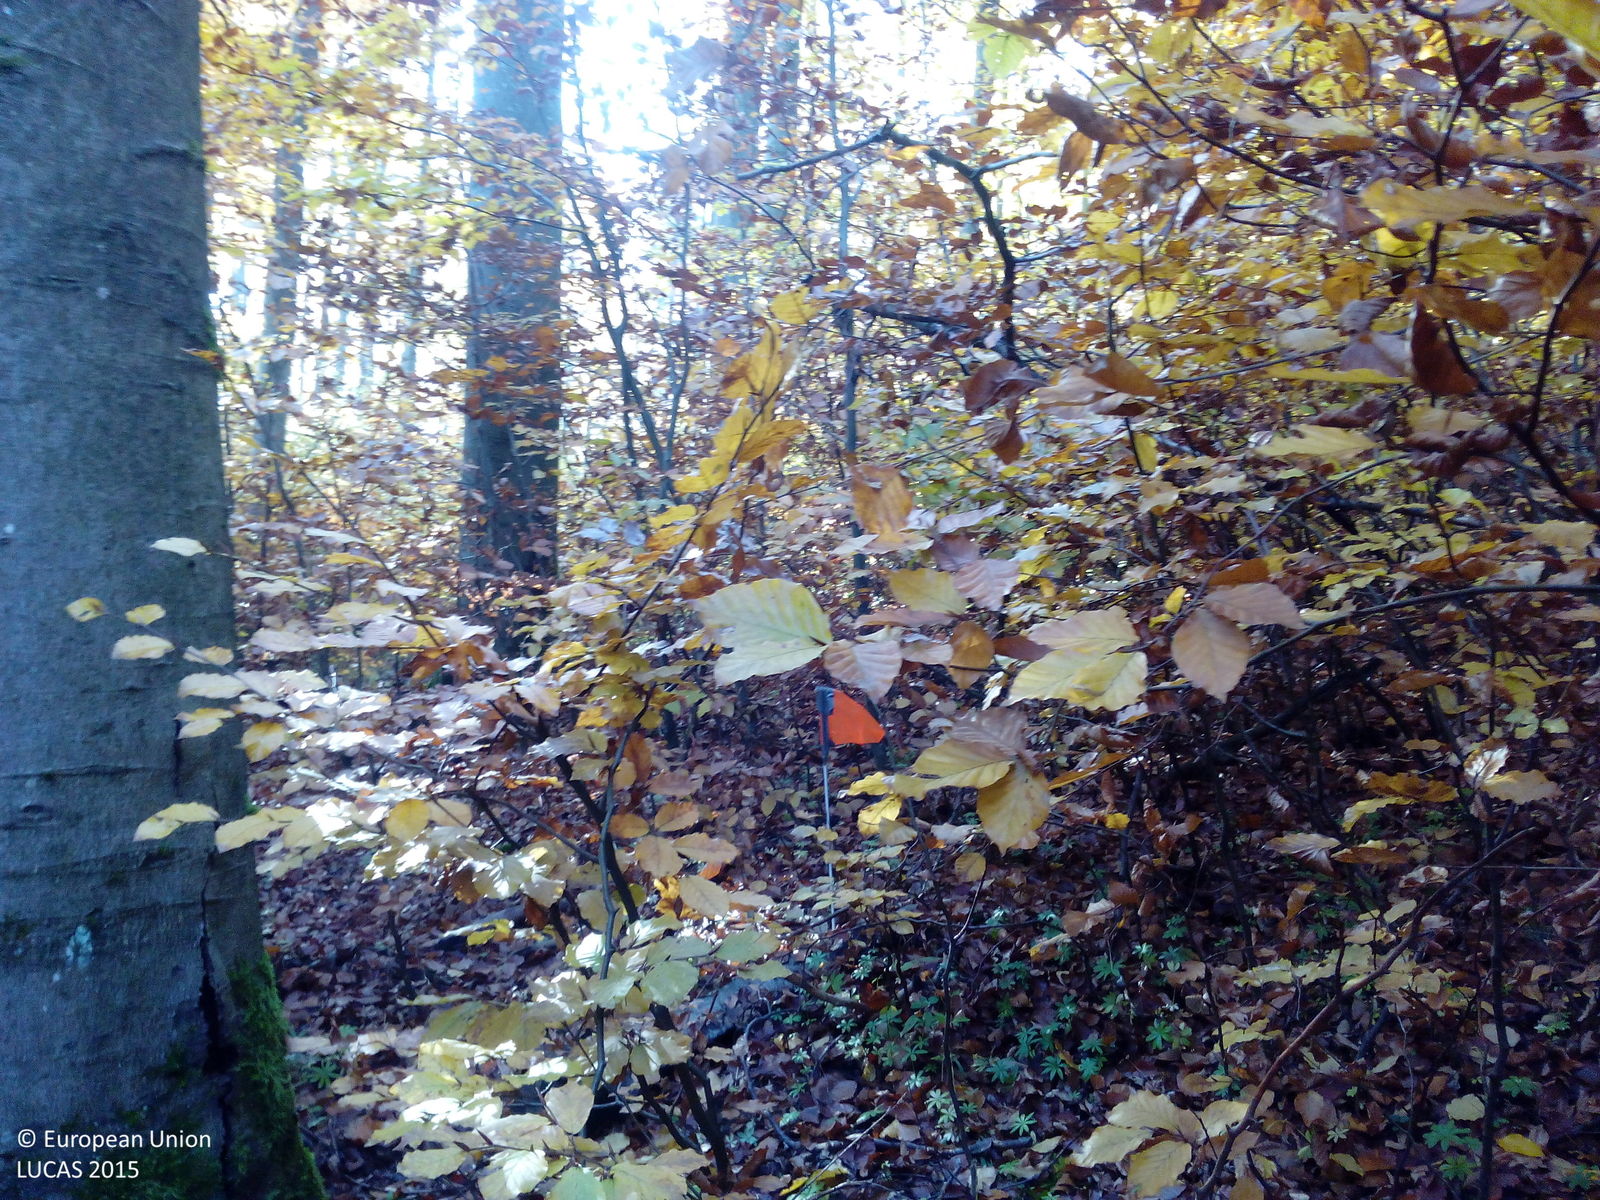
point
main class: Woodland
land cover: Broadleaved woodland
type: beech forest
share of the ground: > 75 %
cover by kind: broadleaved forest trees 85 %, unconsolidated bare surface 10 %, herbaceous plants 5 %
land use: Forestry
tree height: > 5 m
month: October
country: DE
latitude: 50.3281
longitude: 9.9579
